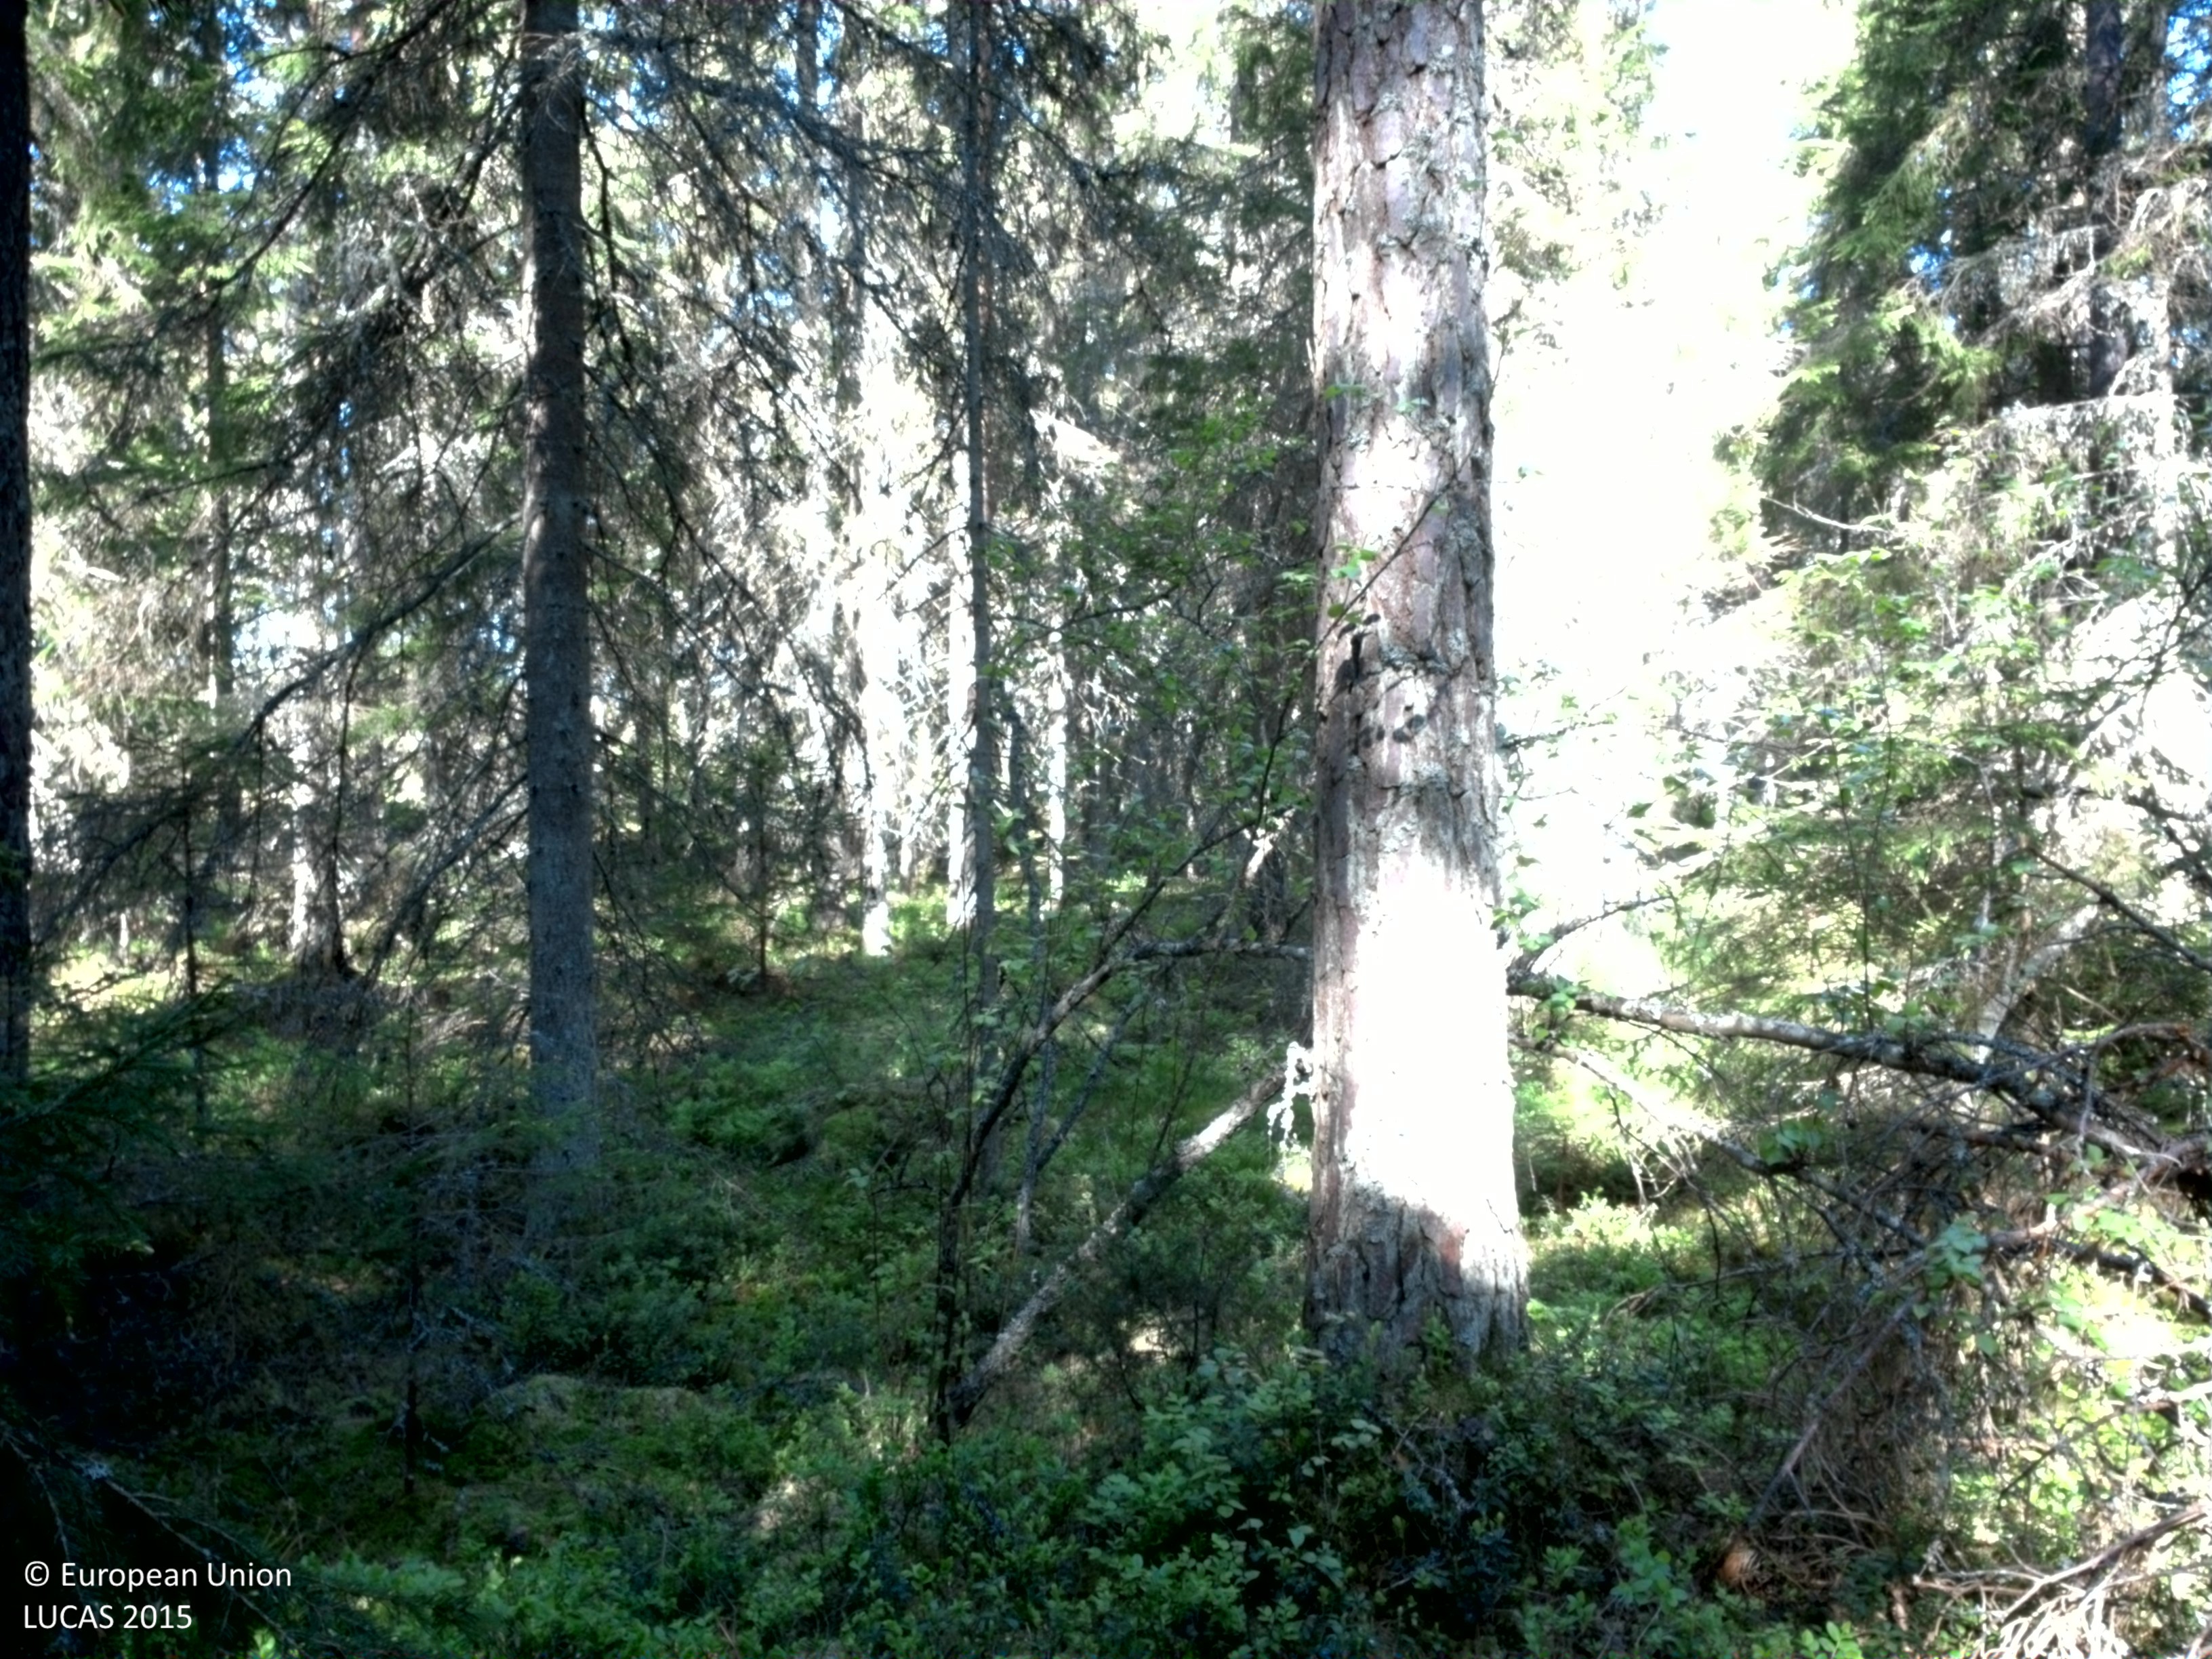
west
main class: Woodland
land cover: Spruce dominated coniferous woodland
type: boreal forest
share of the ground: 50 - 75 %
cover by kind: coniferous forest trees 40 %, shrubs 30 %, lichens and mosses 20 %, broadleaved forest trees 10 %
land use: Forestry
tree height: > 5 m
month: May
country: SE
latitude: 57.3849
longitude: 15.9366
